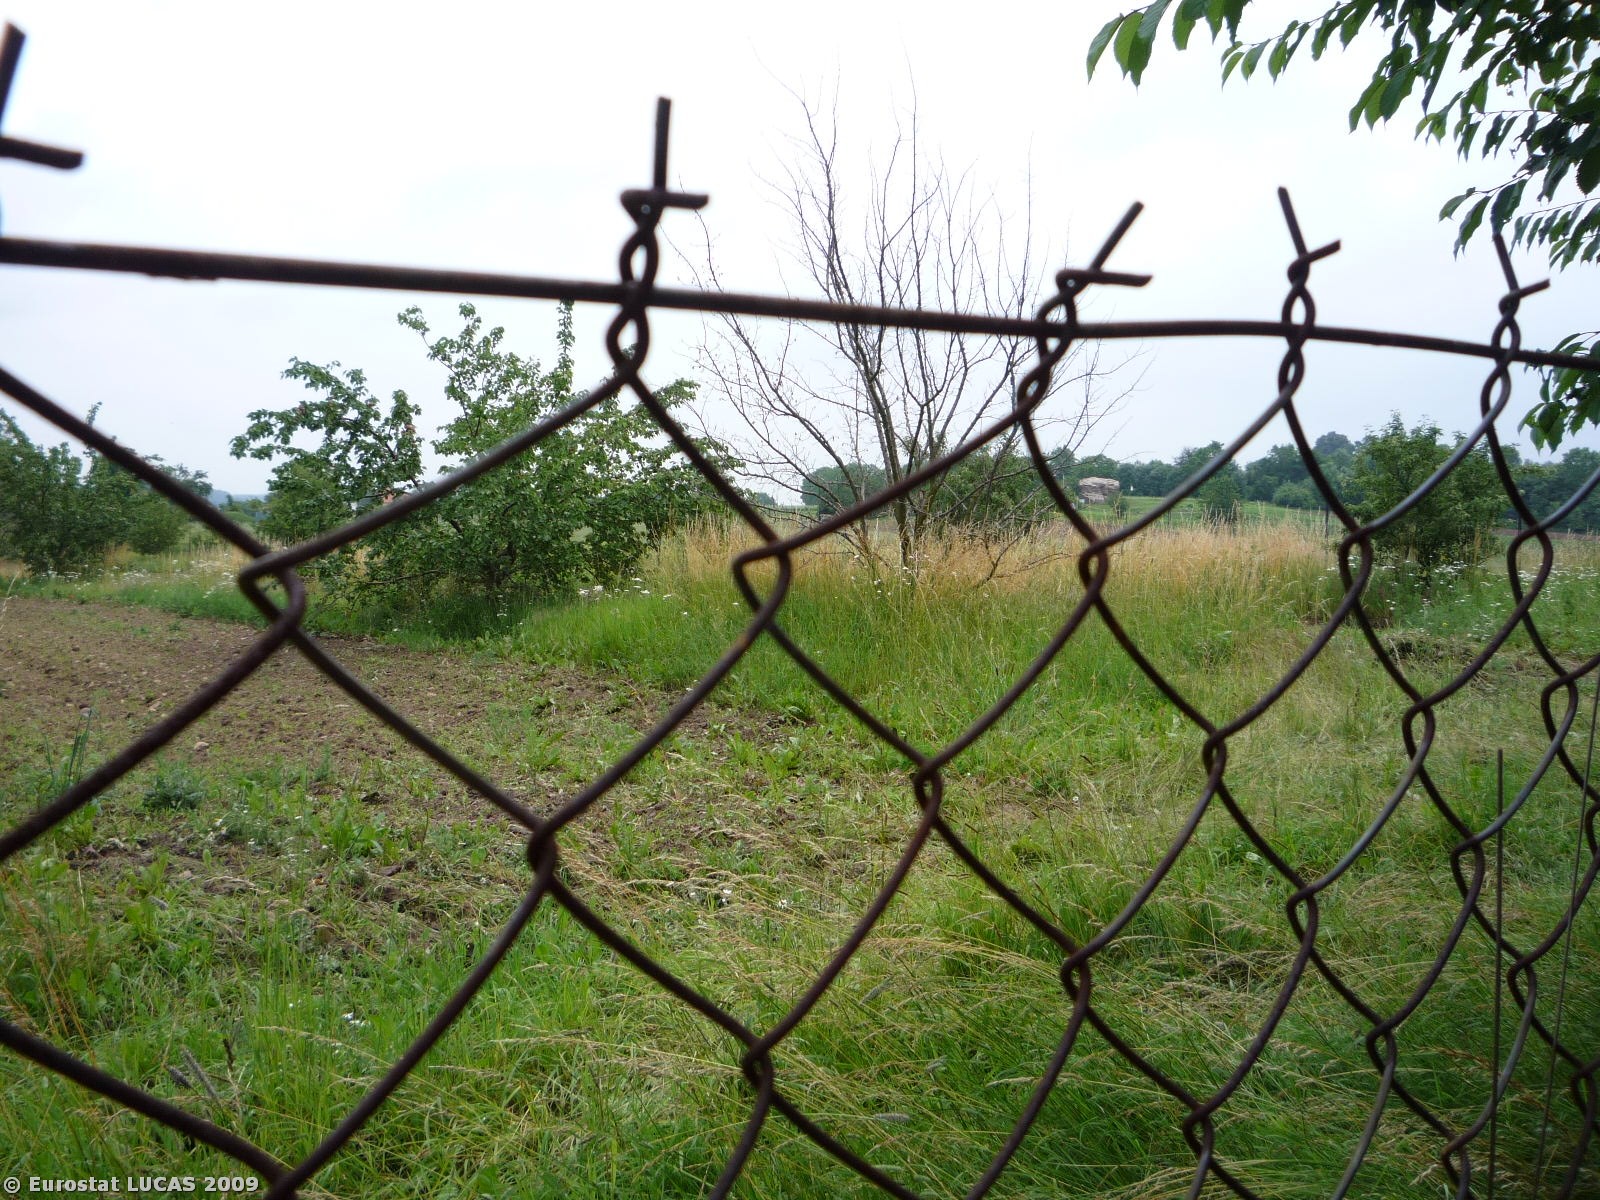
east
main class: Grassland
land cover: Grassland without tree/shrub cover
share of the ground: > 75 %
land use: Agriculture (excluding fallow land and kitchen gardens)
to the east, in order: Grassland without tree/shrub cover; Other fruit trees and berries; Grassland with sparse tree/shrub cover; Fences; Barley; Tracks; Grassland with sparse tree/shrub cover; Ditches and canals; Strawberries
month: June
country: CZ
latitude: 50.0033
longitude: 14.9835
